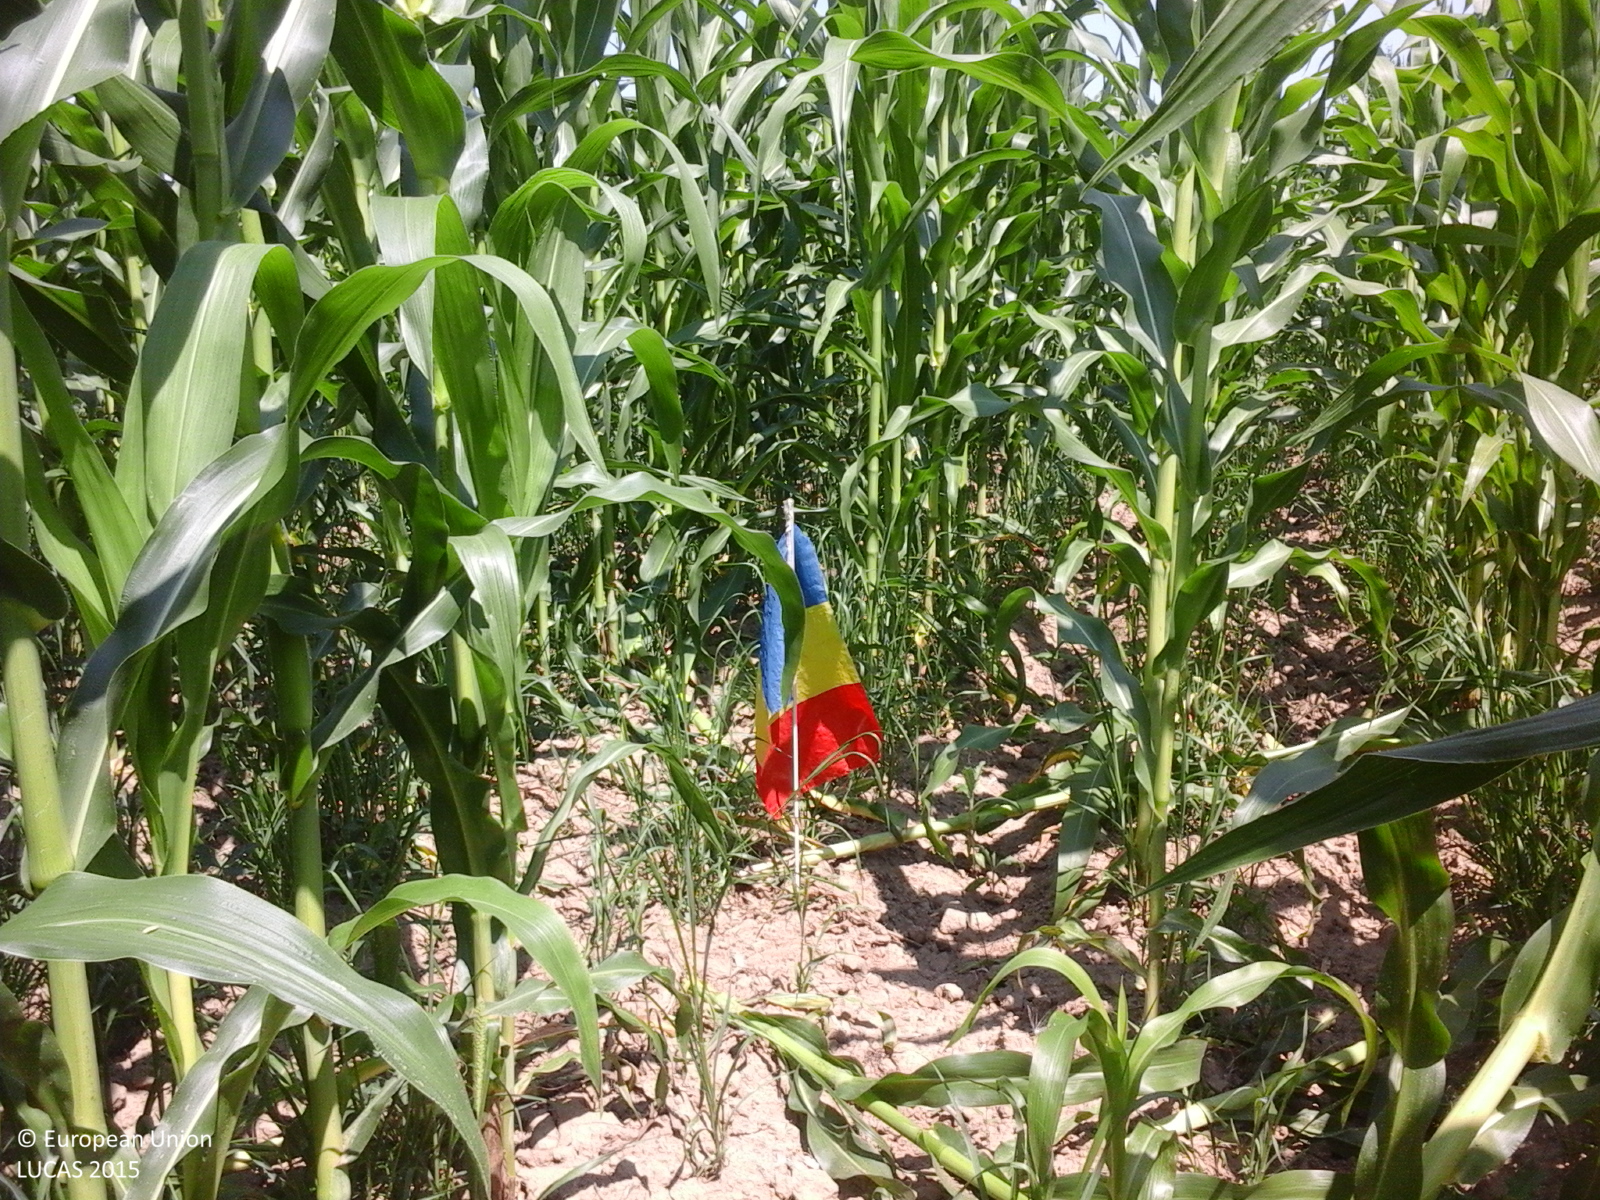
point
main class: Cropland
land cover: Maize
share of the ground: > 75 %
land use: Agriculture (excluding fallow land and kitchen gardens)
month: July
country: RO
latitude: 44.9914
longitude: 24.7558
